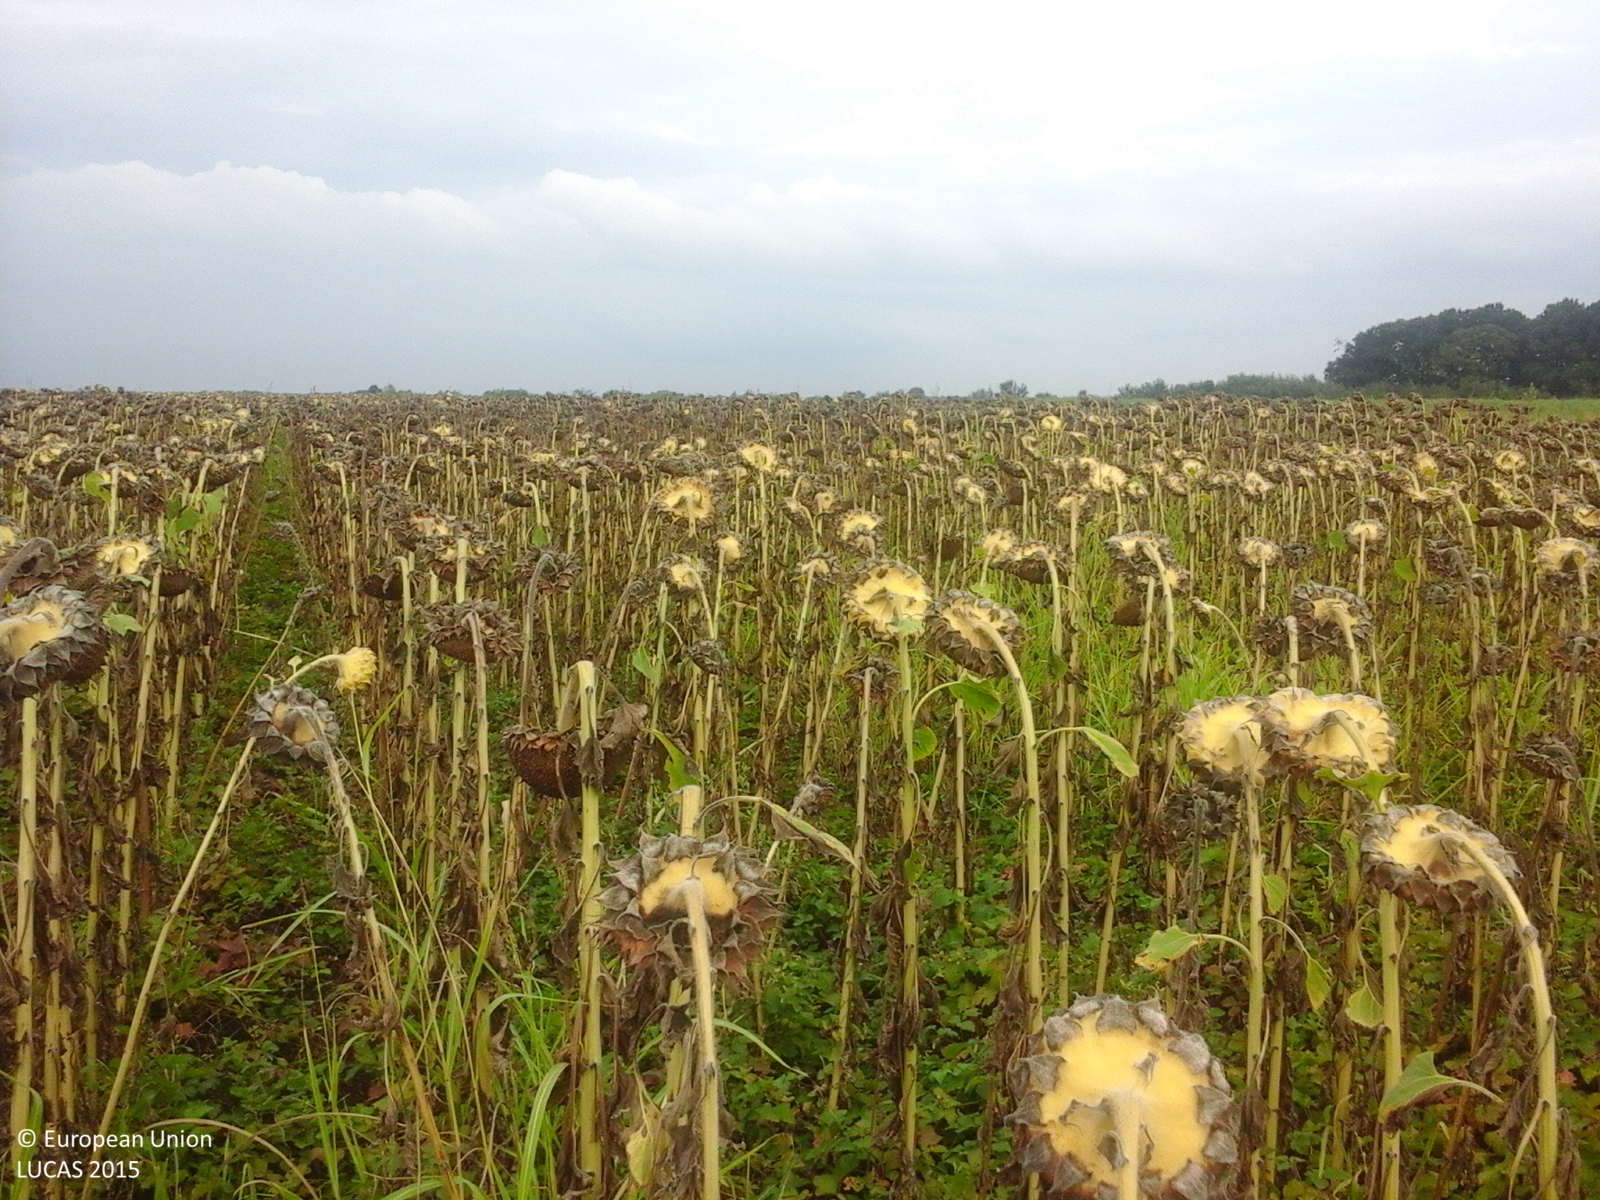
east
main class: Cropland
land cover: Sunflower
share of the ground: > 75 %
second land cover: Spontaneously vegetated surfaces
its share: 50 - 75 %
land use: Agriculture (excluding fallow land and kitchen gardens)
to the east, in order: Sunflower; Spontaneously vegetated surfaces; Lucerne; Soya
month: August
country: RO
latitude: 46.0168
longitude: 20.8386
